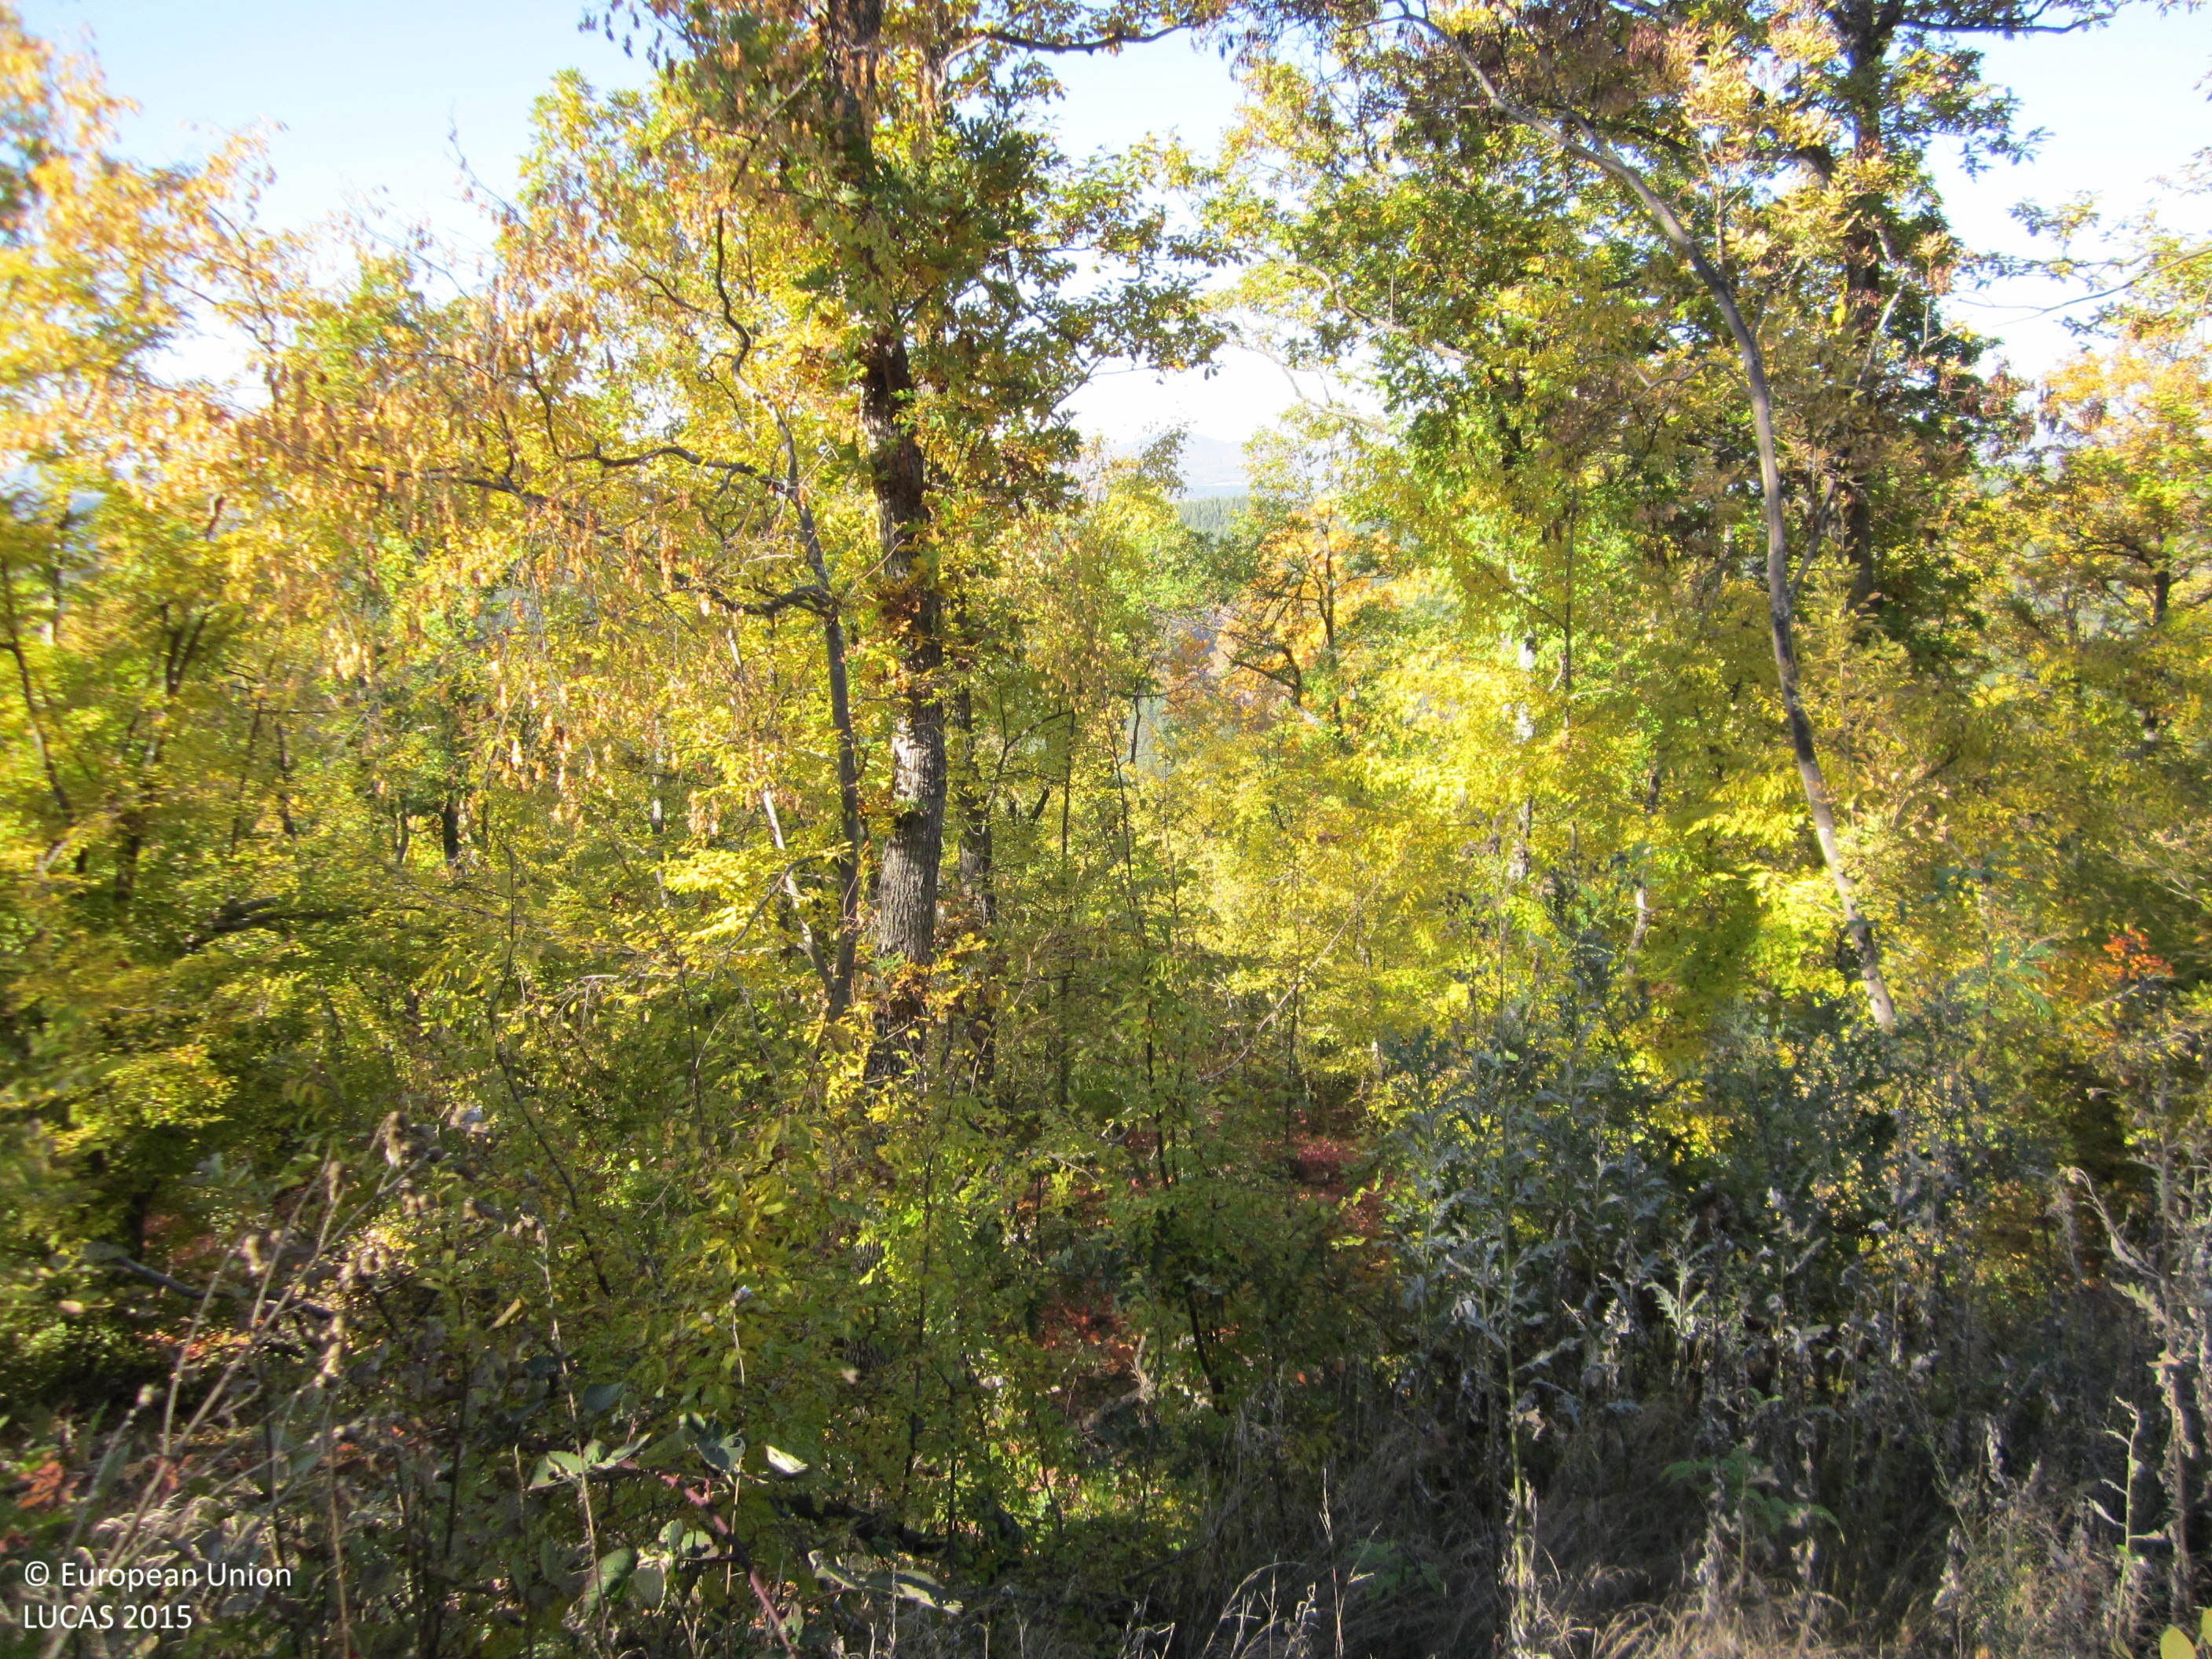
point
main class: Woodland
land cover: Broadleaved woodland
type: mesophytic deciduous forest
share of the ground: > 75 %
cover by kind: broadleaved forest trees 80 %, shrubs 10 %, herbaceous plants 10 %
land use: Forestry
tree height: > 5 m
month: November
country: BG
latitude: 41.6112
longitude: 25.7725
